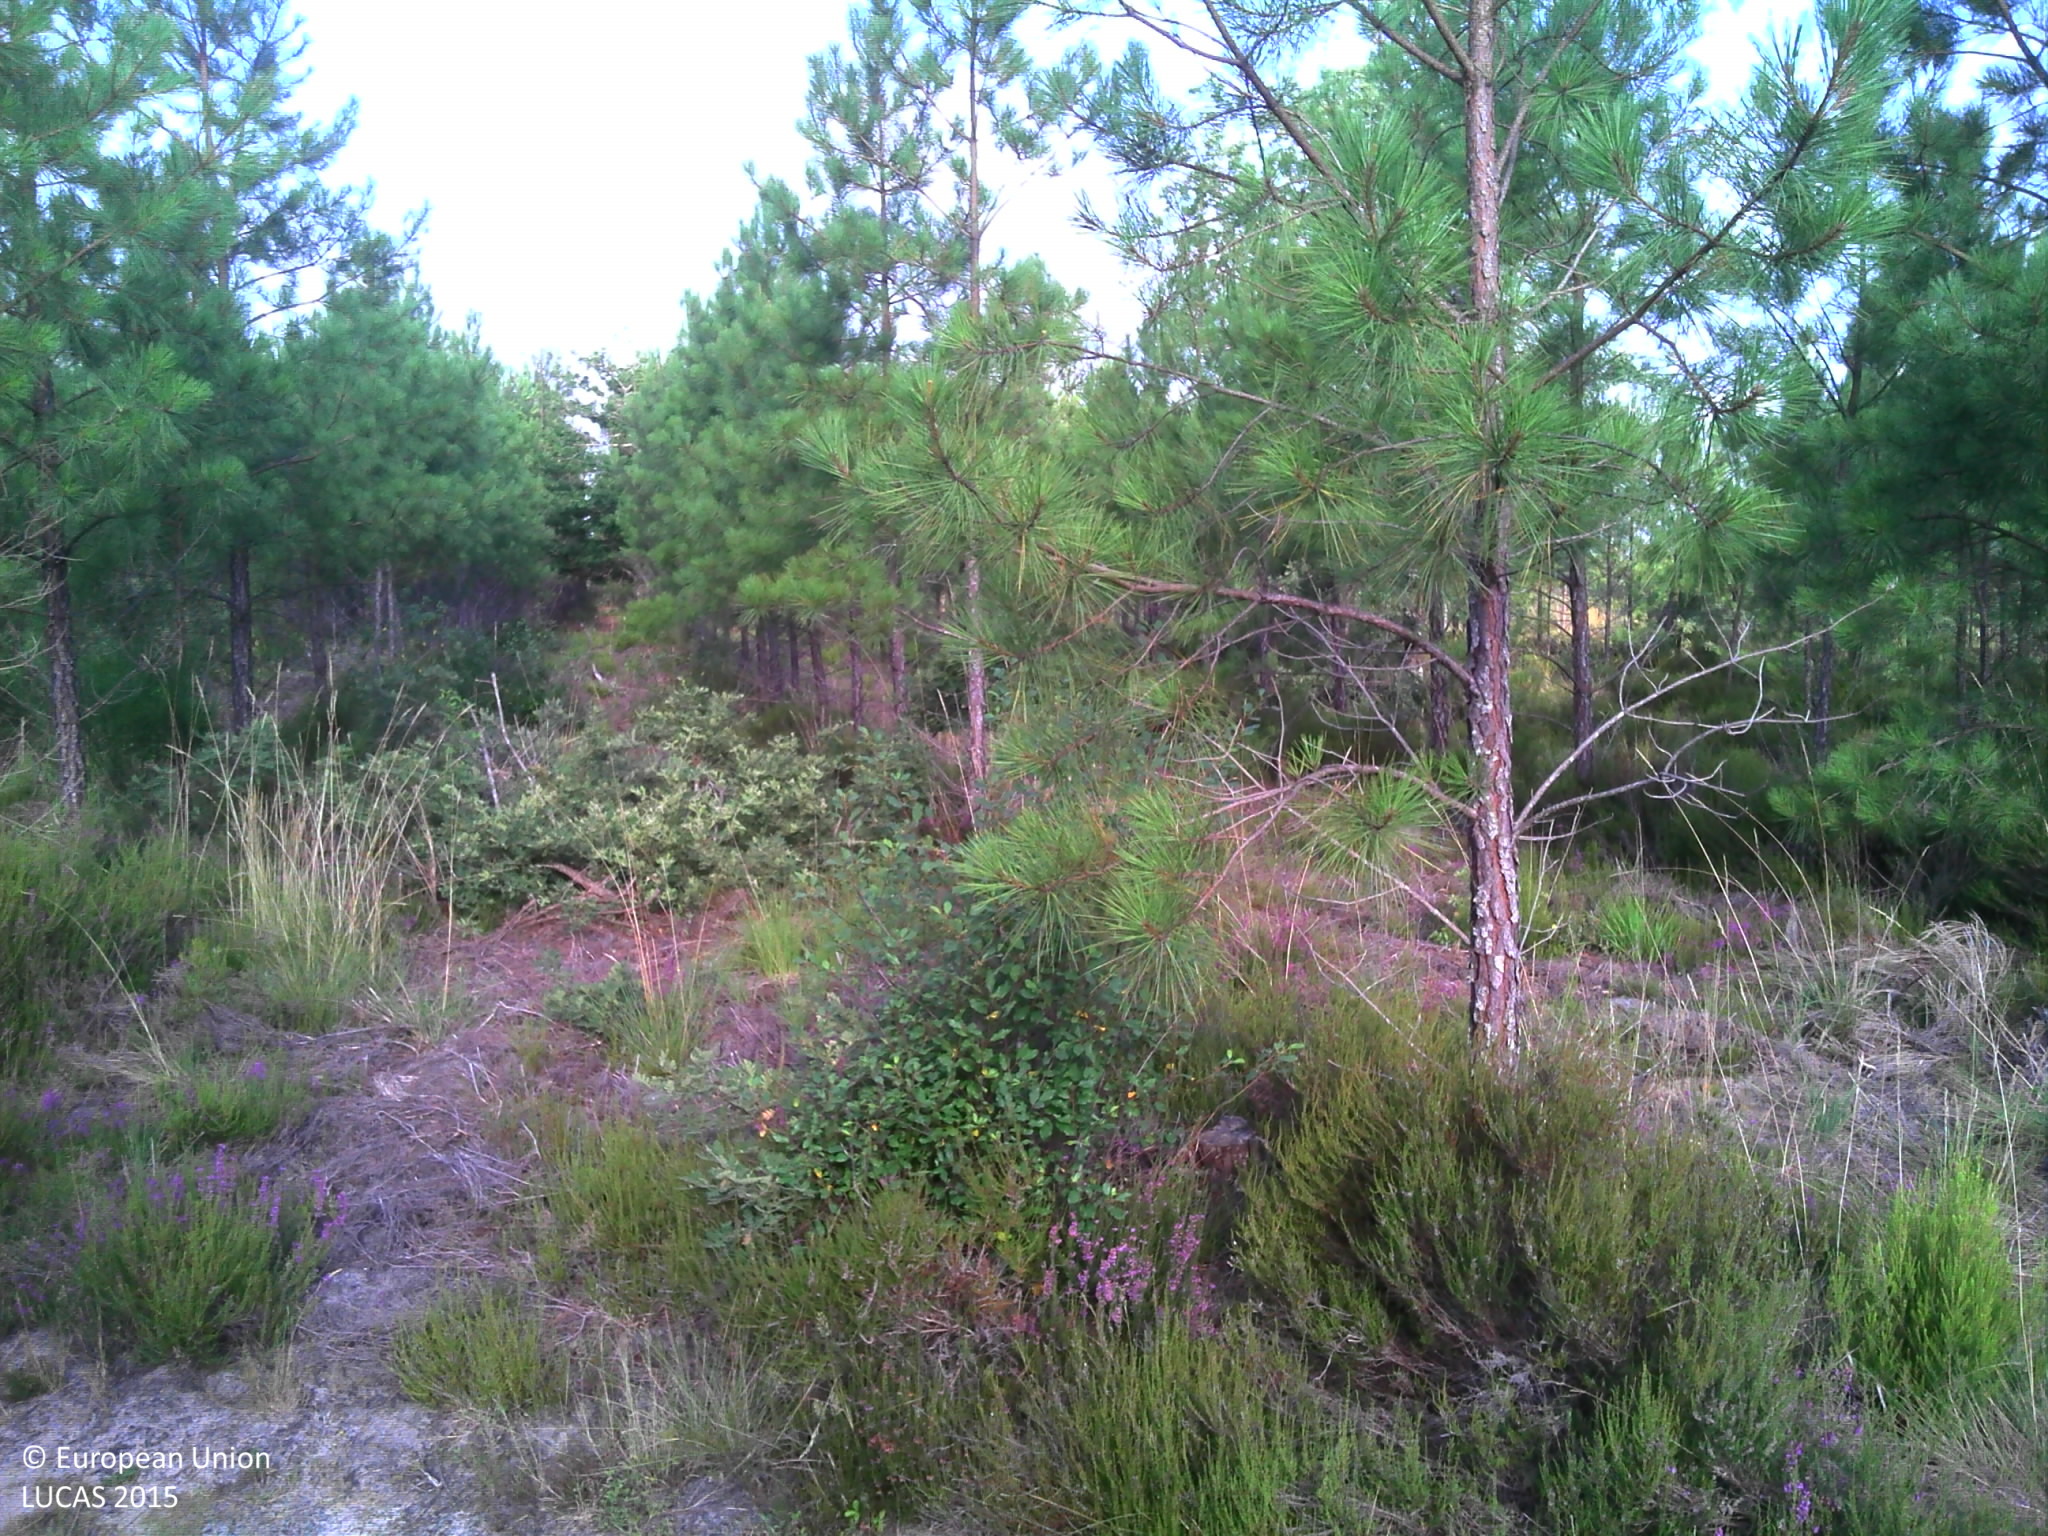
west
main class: Woodland
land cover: Pine dominated coniferous woodland
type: coniferous forest of the mediterranean region
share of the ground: 50 - 75 %
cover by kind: coniferous forest trees 70 %, herbaceous plants 20 %, broadleaved forest trees 10 %
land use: Forestry
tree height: < 5 m
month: July
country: FR
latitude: 44.0644
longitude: -0.5629
